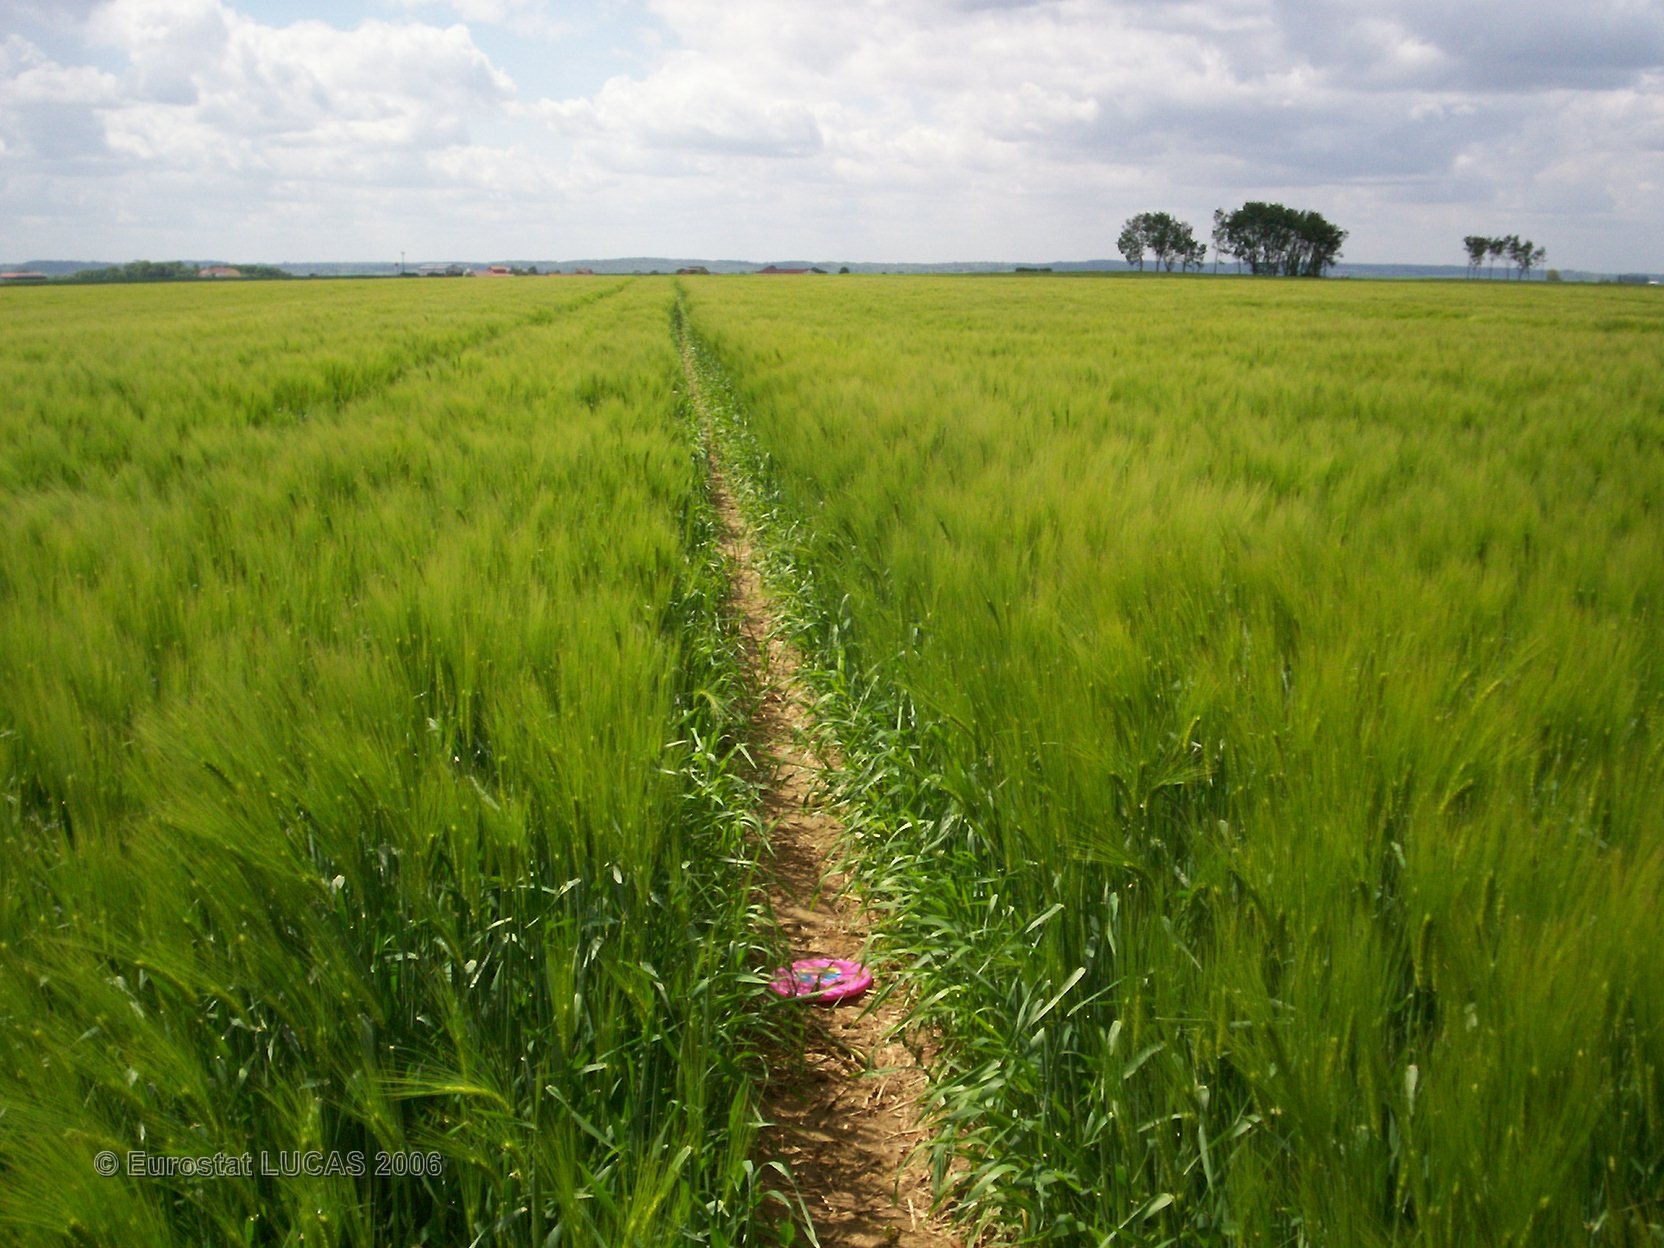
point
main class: Cropland
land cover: Common wheat
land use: Agriculture (excluding fallow land and kitchen gardens)
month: May
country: FR
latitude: 48.9646
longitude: 2.8192
